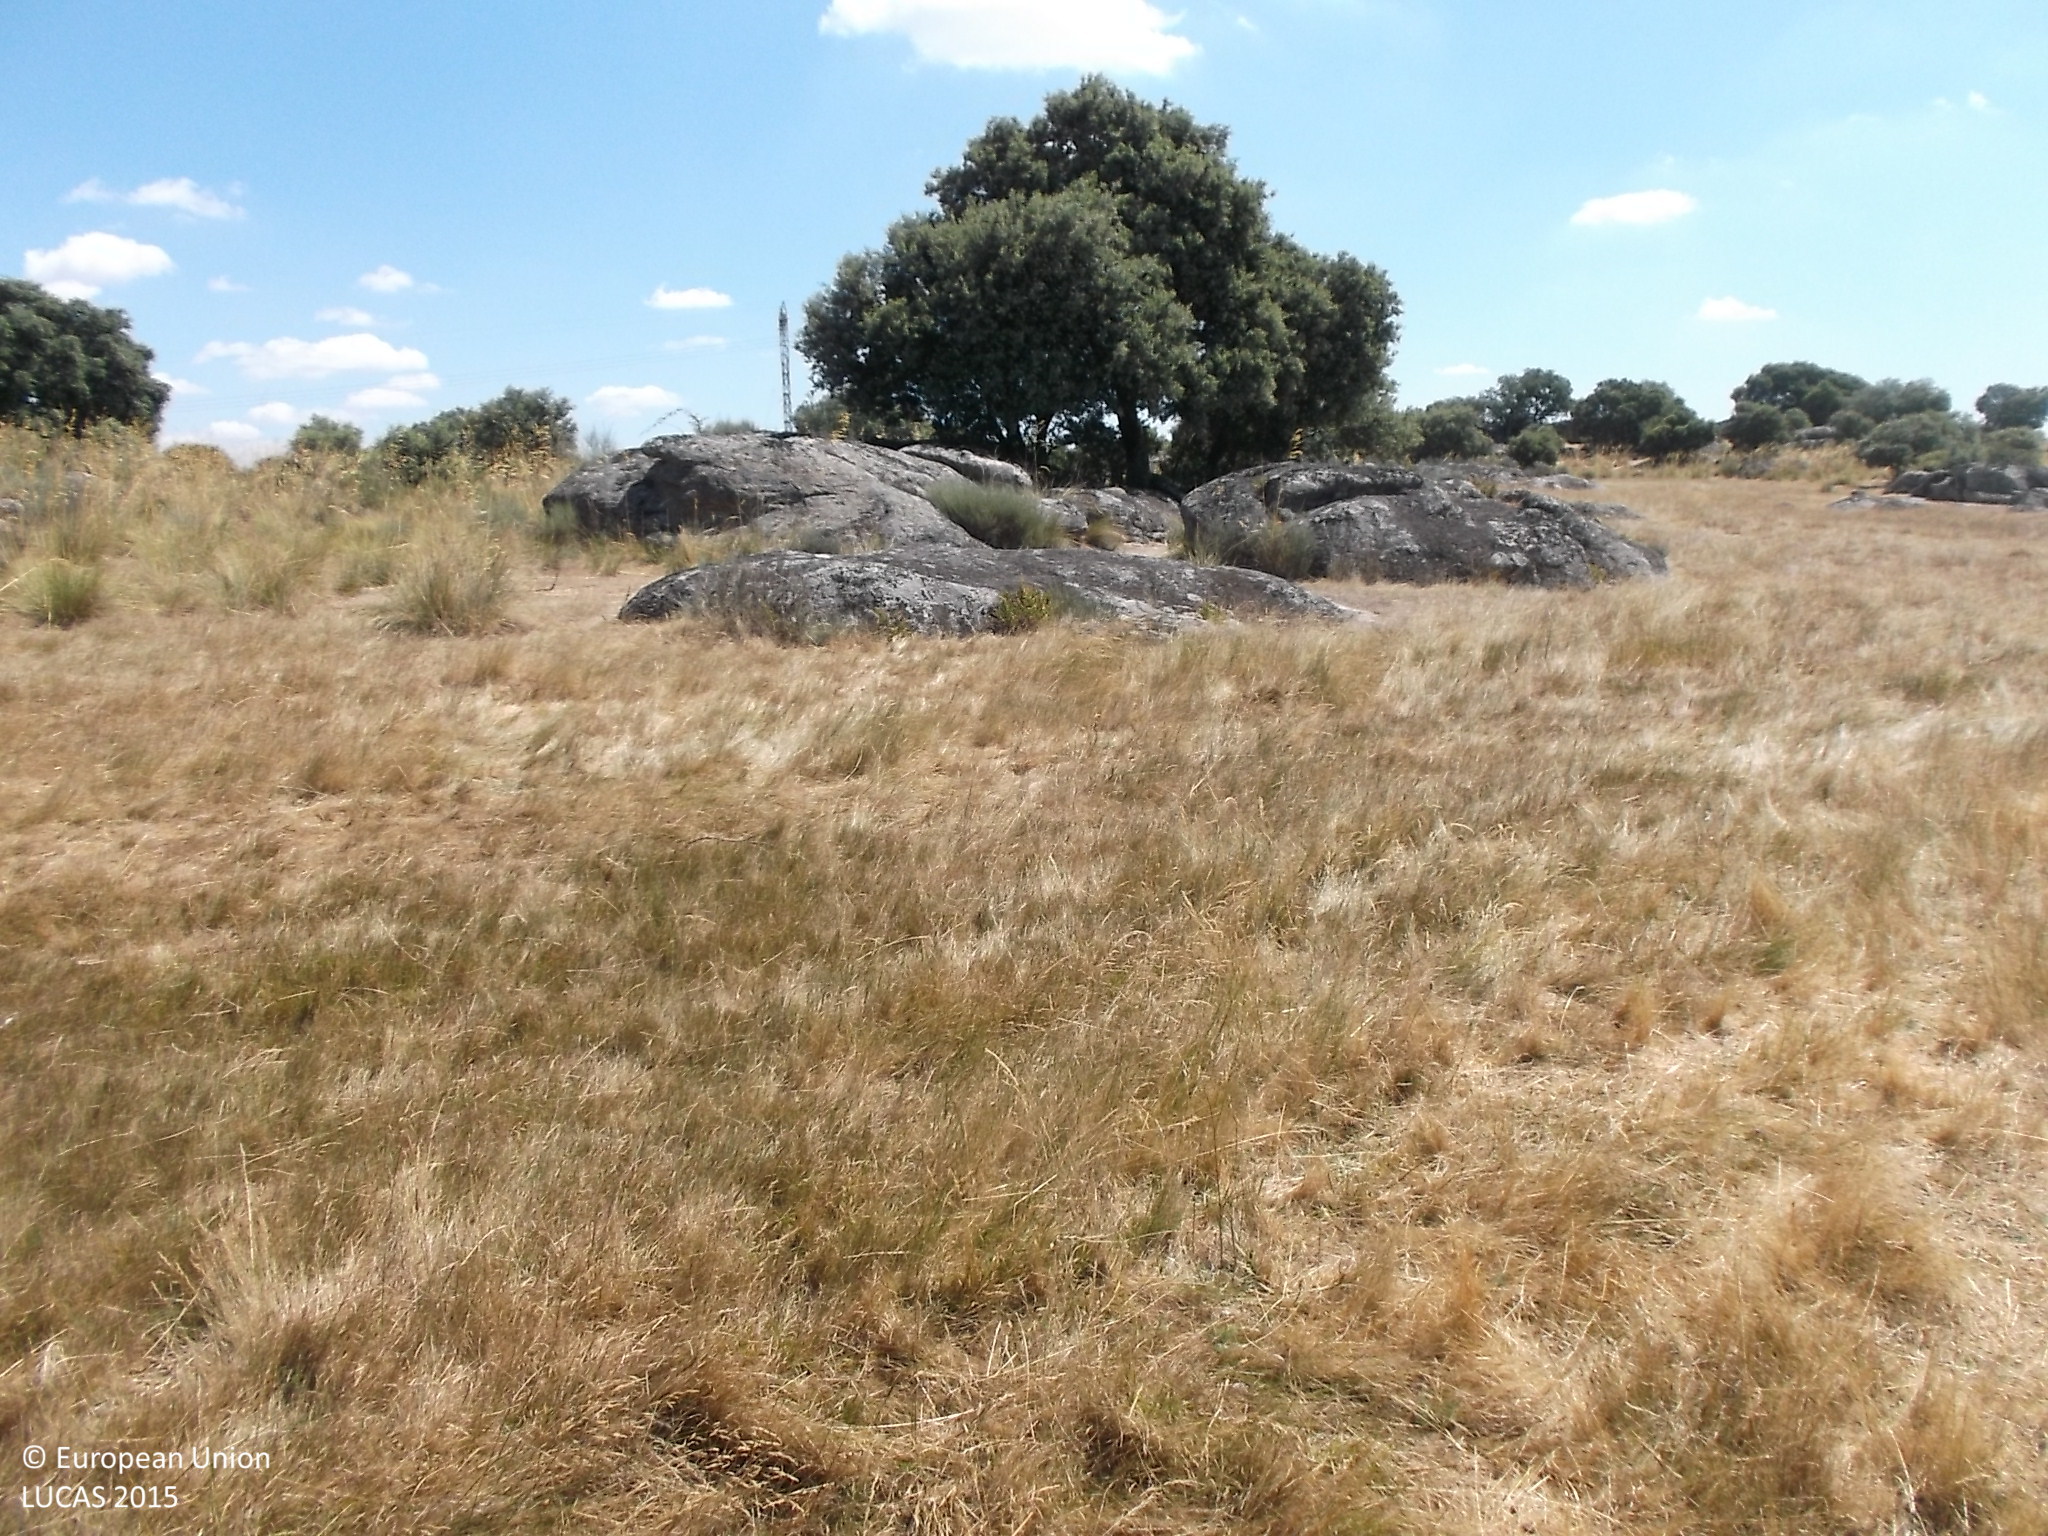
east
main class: Grassland
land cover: Grassland without tree/shrub cover
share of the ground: > 75 %
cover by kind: herbaceous plants 100 %
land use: Agriculture (excluding fallow land and kitchen gardens)
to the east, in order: Grassland without tree/shrub cover; Rocks and stones; Grassland with sparse tree/shrub cover; Rocks and stones
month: July
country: ES
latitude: 41.4210
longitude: -6.0407
